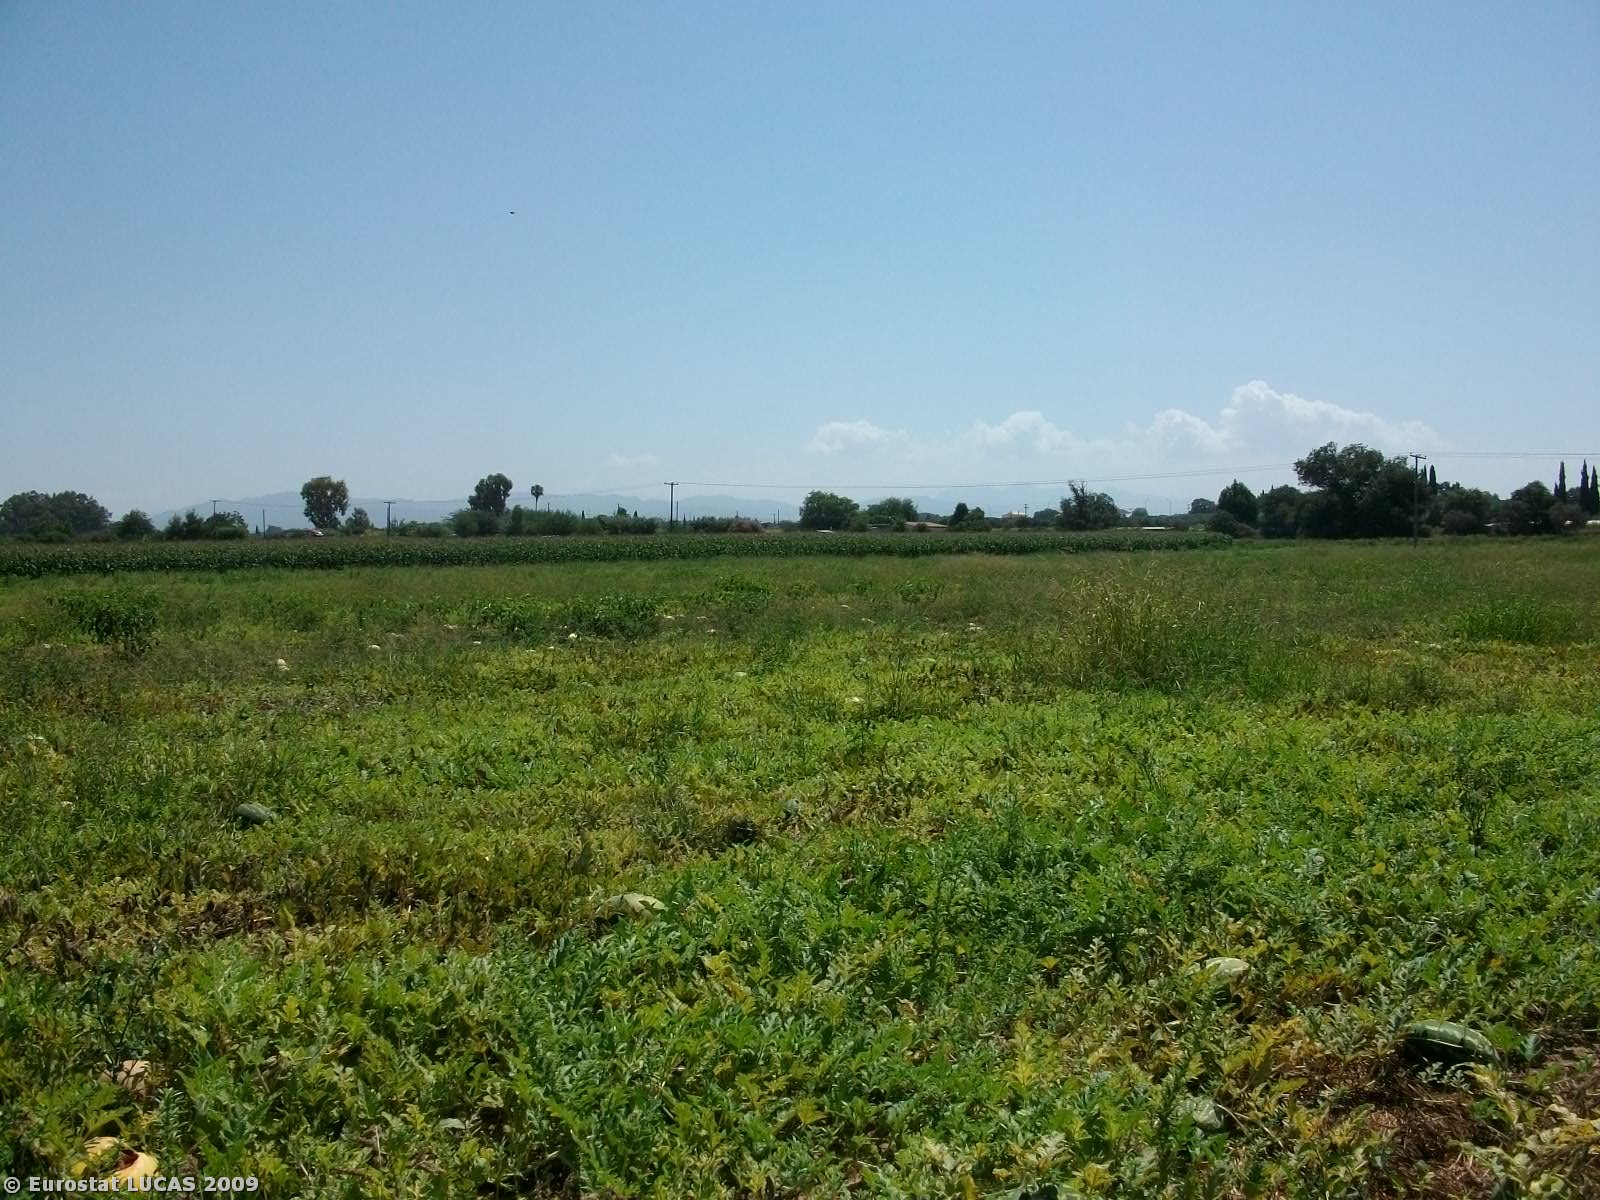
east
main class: Cropland
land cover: Other fresh vegetables
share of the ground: 50 - 75 %
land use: Agriculture (excluding fallow land and kitchen gardens)
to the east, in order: Other fresh vegetables; Maize; Electric lines; Maize
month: July
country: GR
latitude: 38.0179
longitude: 21.3418
